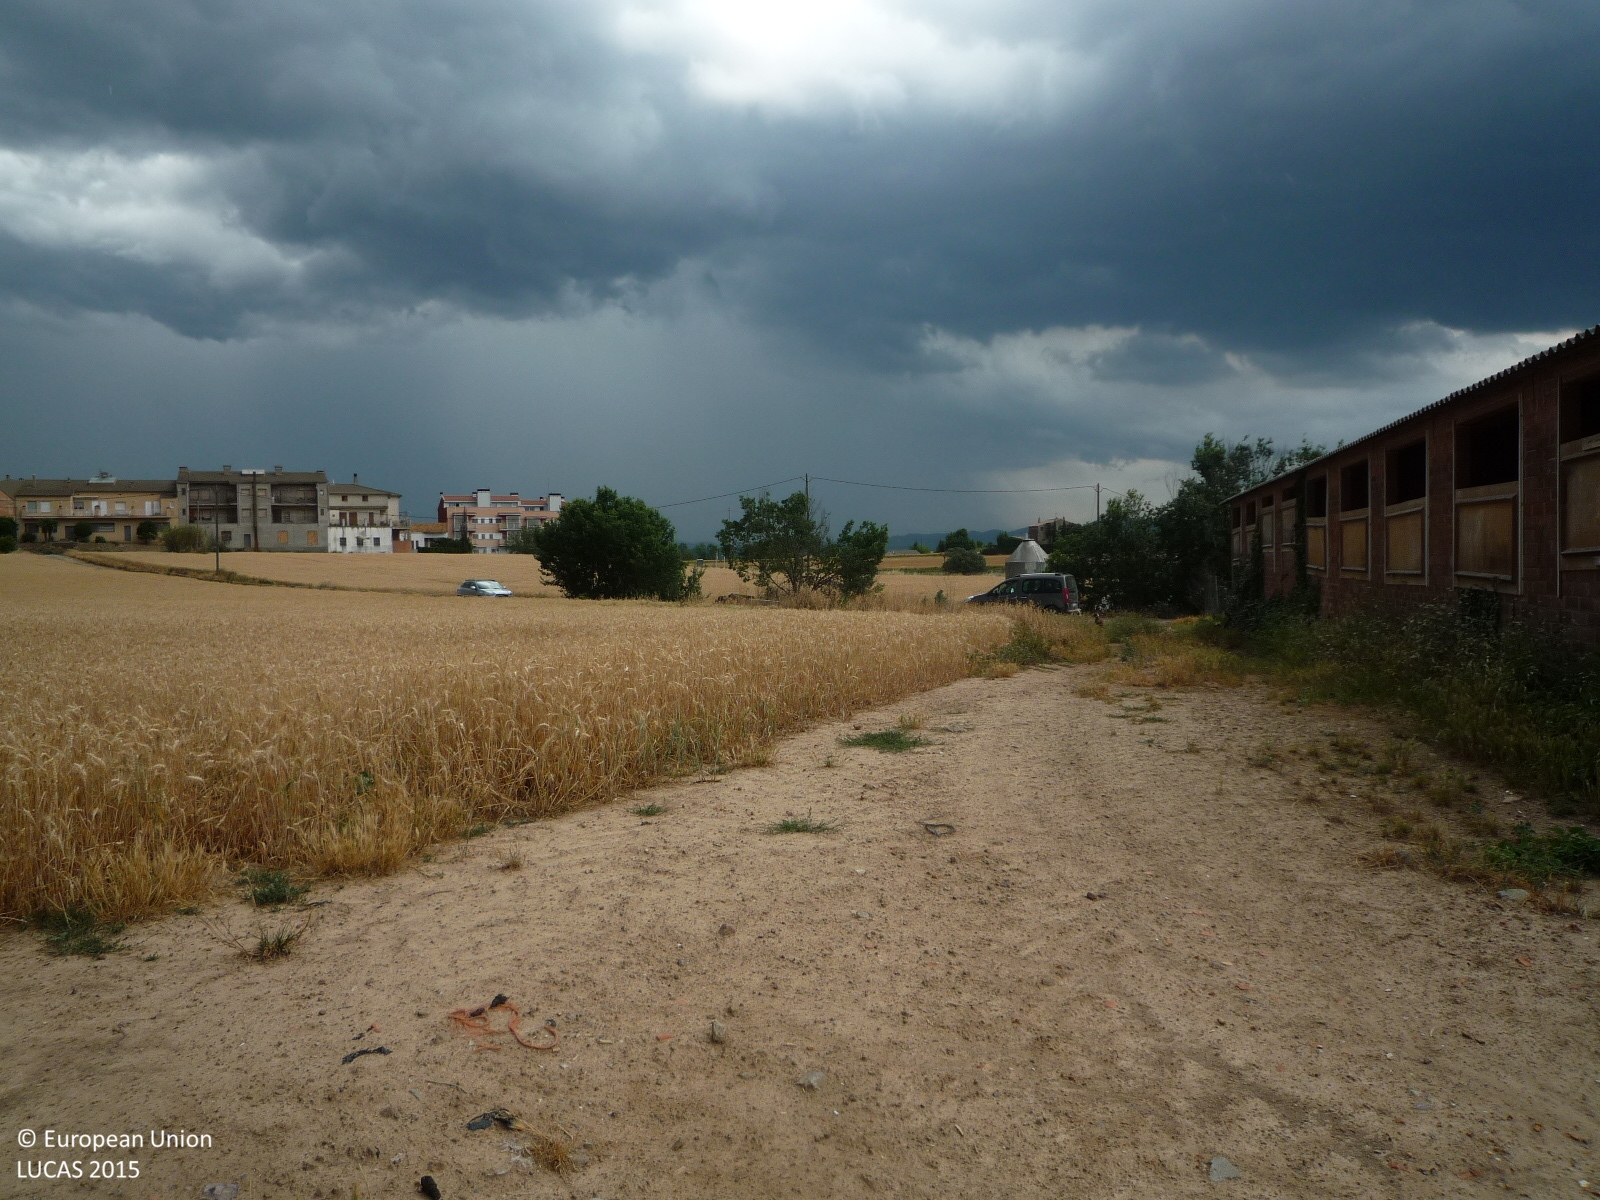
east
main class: Shrubland
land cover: Shrubland with sparse tree cover
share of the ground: > 75 %
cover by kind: shrubs 95 %, broadleaved forest trees 5 %
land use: Semi-natural and natural areas not in use
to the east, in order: Shrubland with sparse tree cover; Arable land (only in case pi); Pine dominated mixed woodland; Olive groves; Shrubland with sparse tree cover; Pine dominated mixed woodland
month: June
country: ES
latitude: 41.9395
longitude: 2.0176
